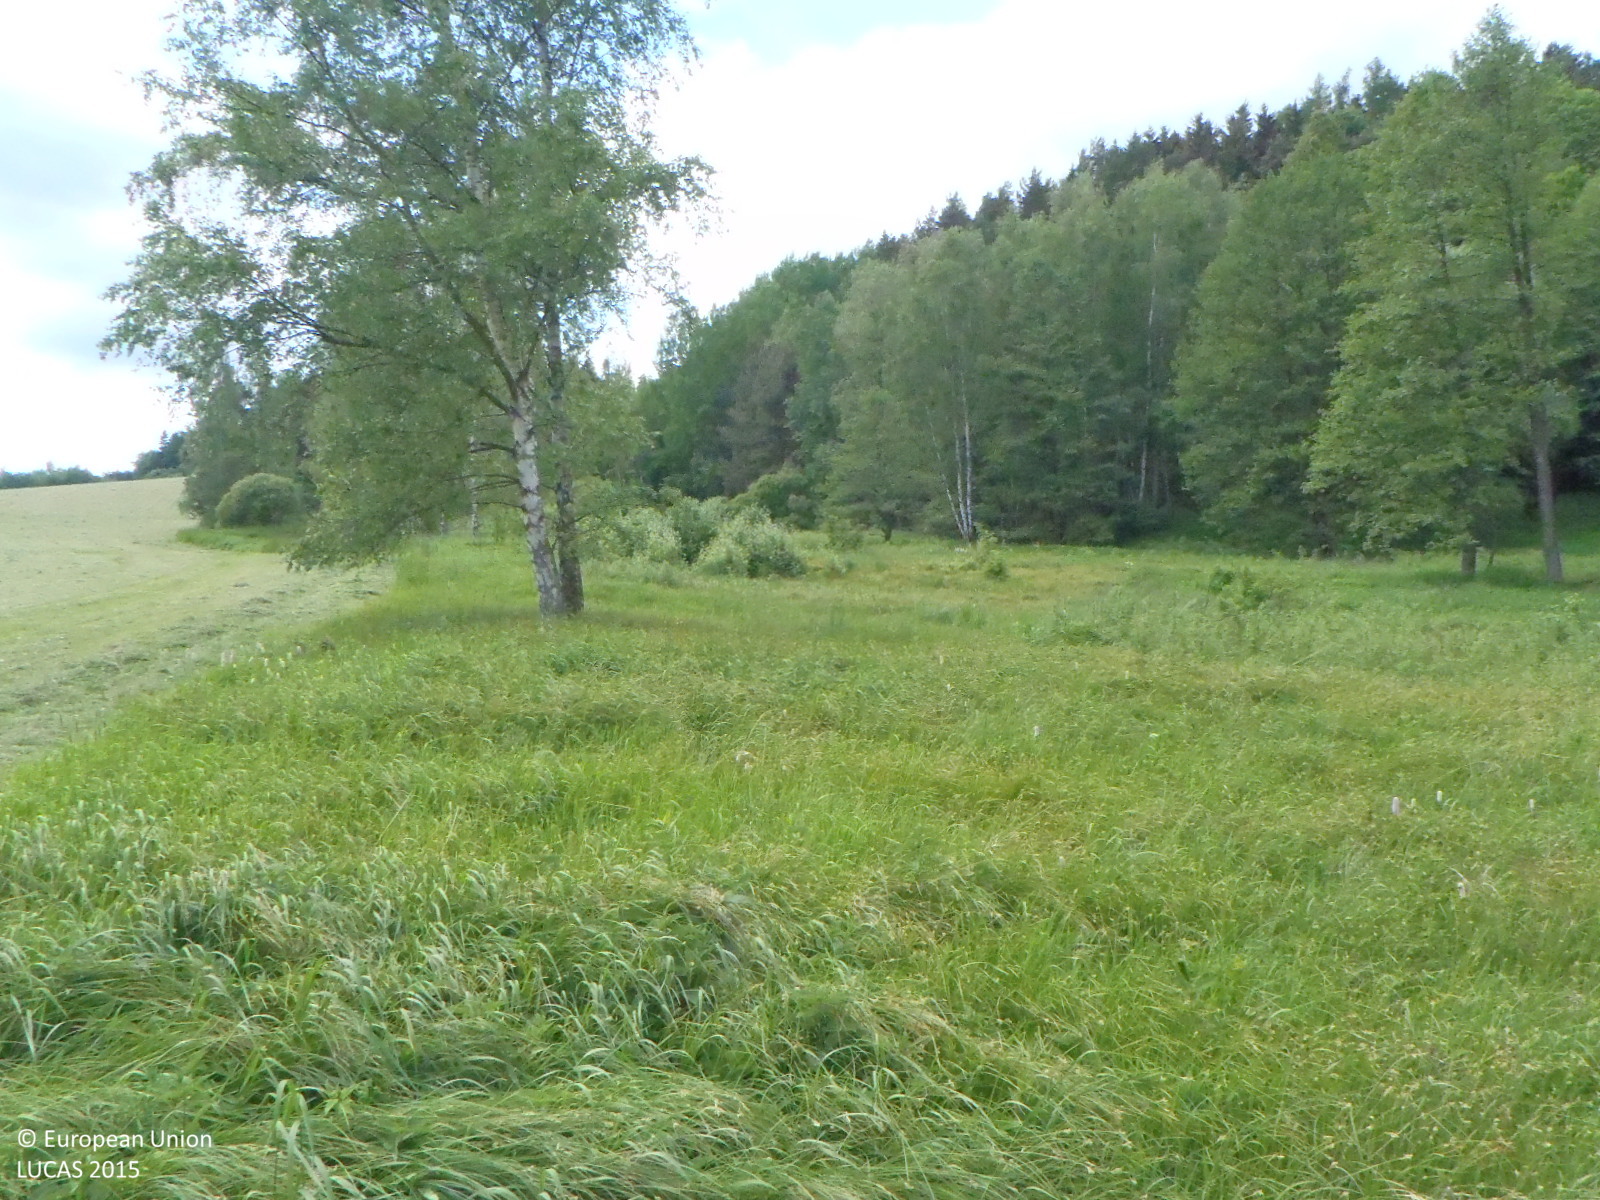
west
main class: Grassland
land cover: Grassland with sparse tree/shrub cover
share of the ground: > 75 %
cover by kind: herbaceous plants 95 %, broadleaved forest trees 5 %
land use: Forestry
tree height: > 5 m
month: June
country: CZ
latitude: 48.6567
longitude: 14.4400
